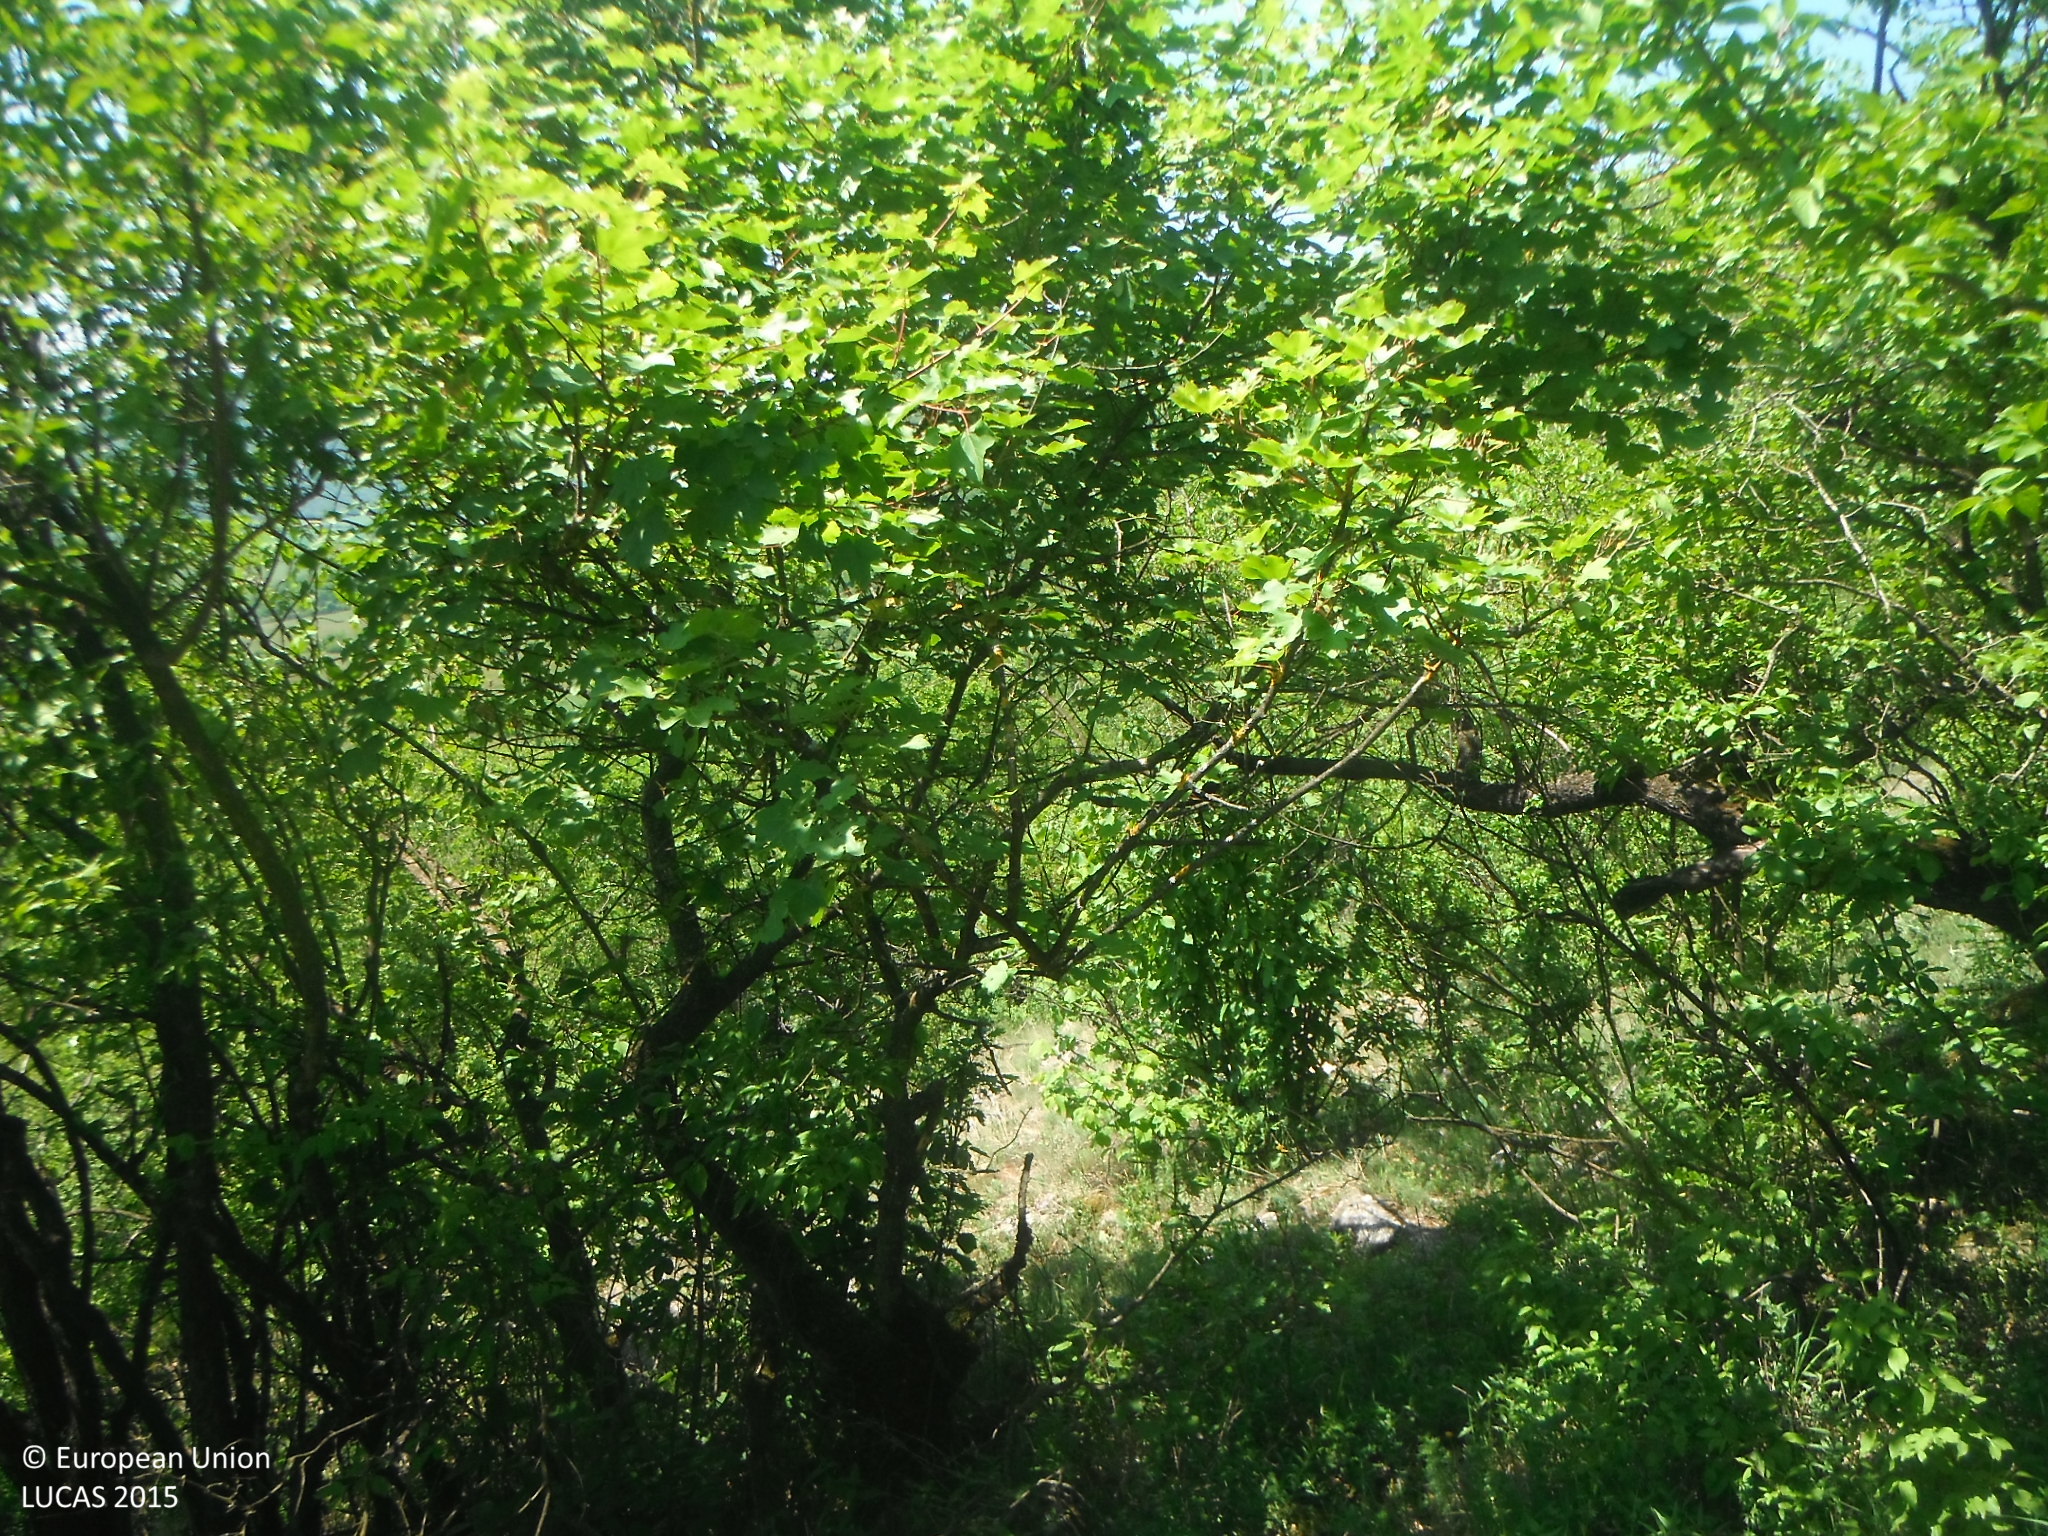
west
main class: Woodland
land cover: Broadleaved woodland
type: mesophytic deciduous forest
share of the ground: 10 - 25 %
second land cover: Shrubland without tree cover
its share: 50 - 75 %
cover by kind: shrubs 60 %, broadleaved forest trees 25 %, herbaceous plants 15 %
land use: Semi-natural and natural areas not in use
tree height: > 5 m
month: May
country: SK
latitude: 48.6247
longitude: 20.9071
